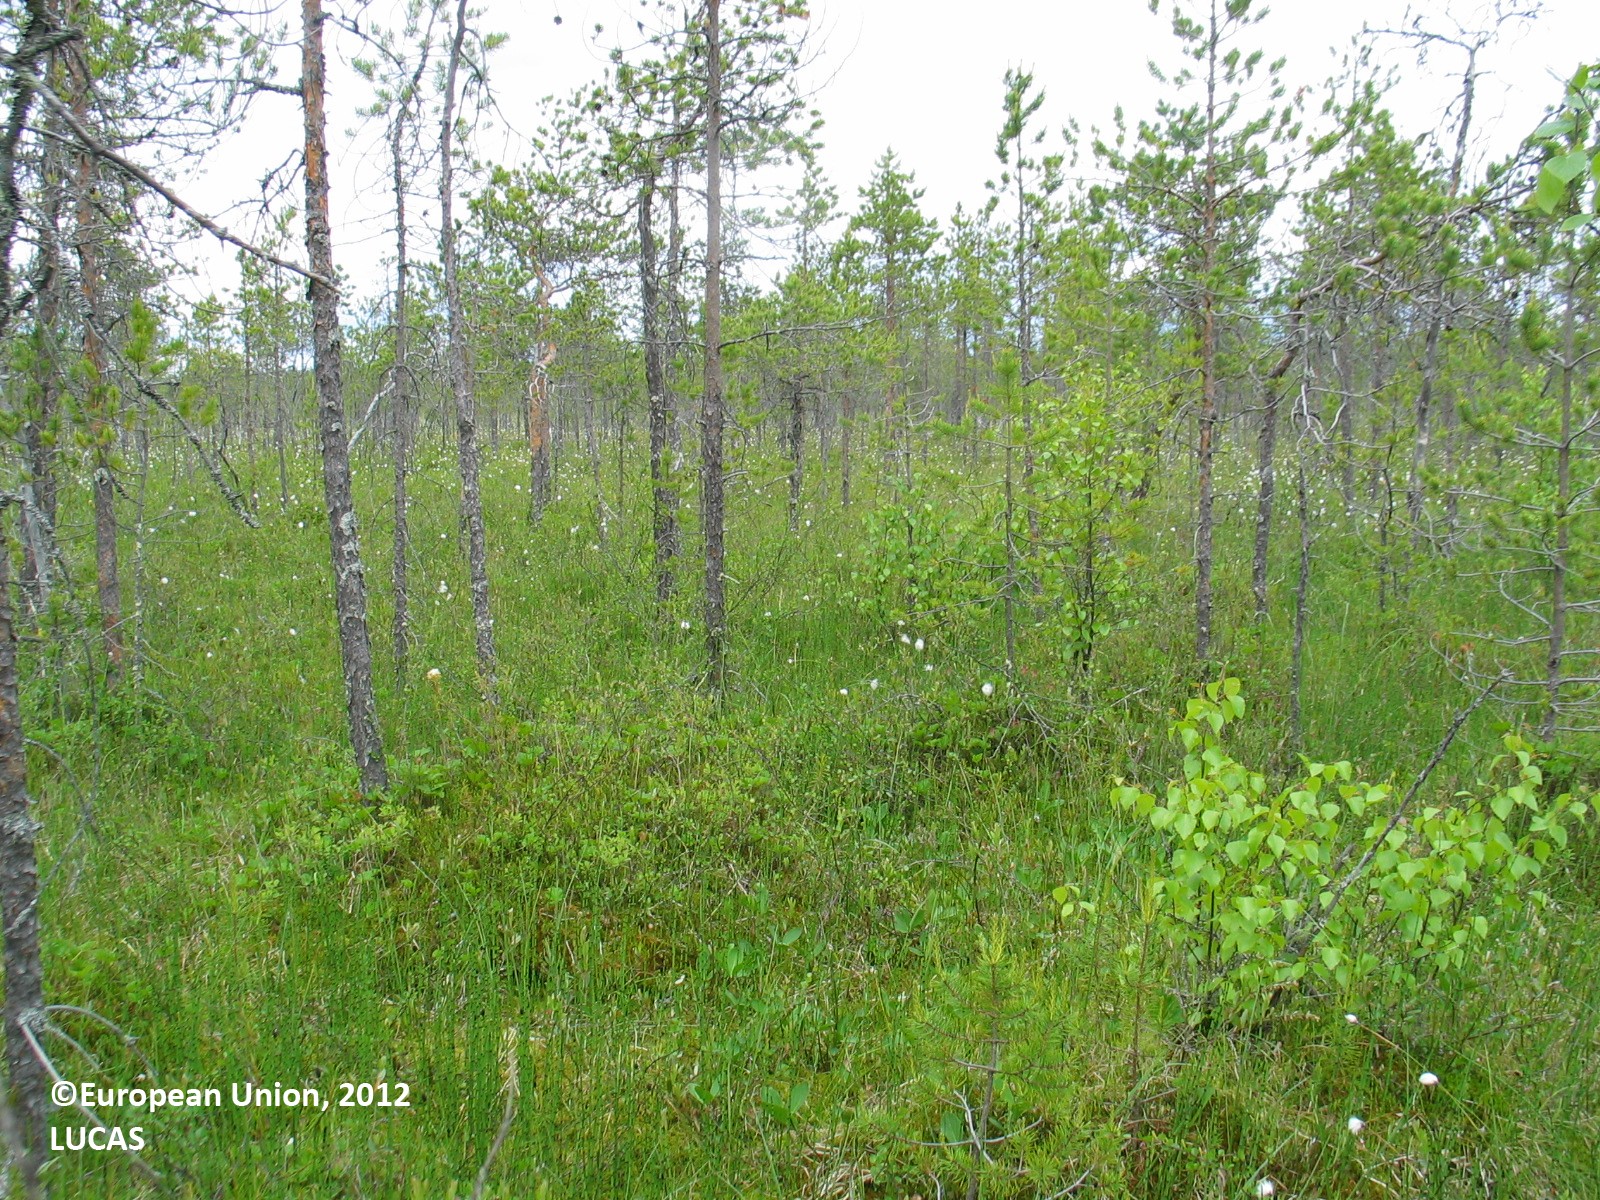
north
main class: Woodland
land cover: Pine dominated coniferous woodland
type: mire and swamp forests
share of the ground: 10 - 25 %
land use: Semi-natural and natural areas not in use
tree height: > 5 m
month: June
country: FI
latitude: 64.8653
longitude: 26.6351
